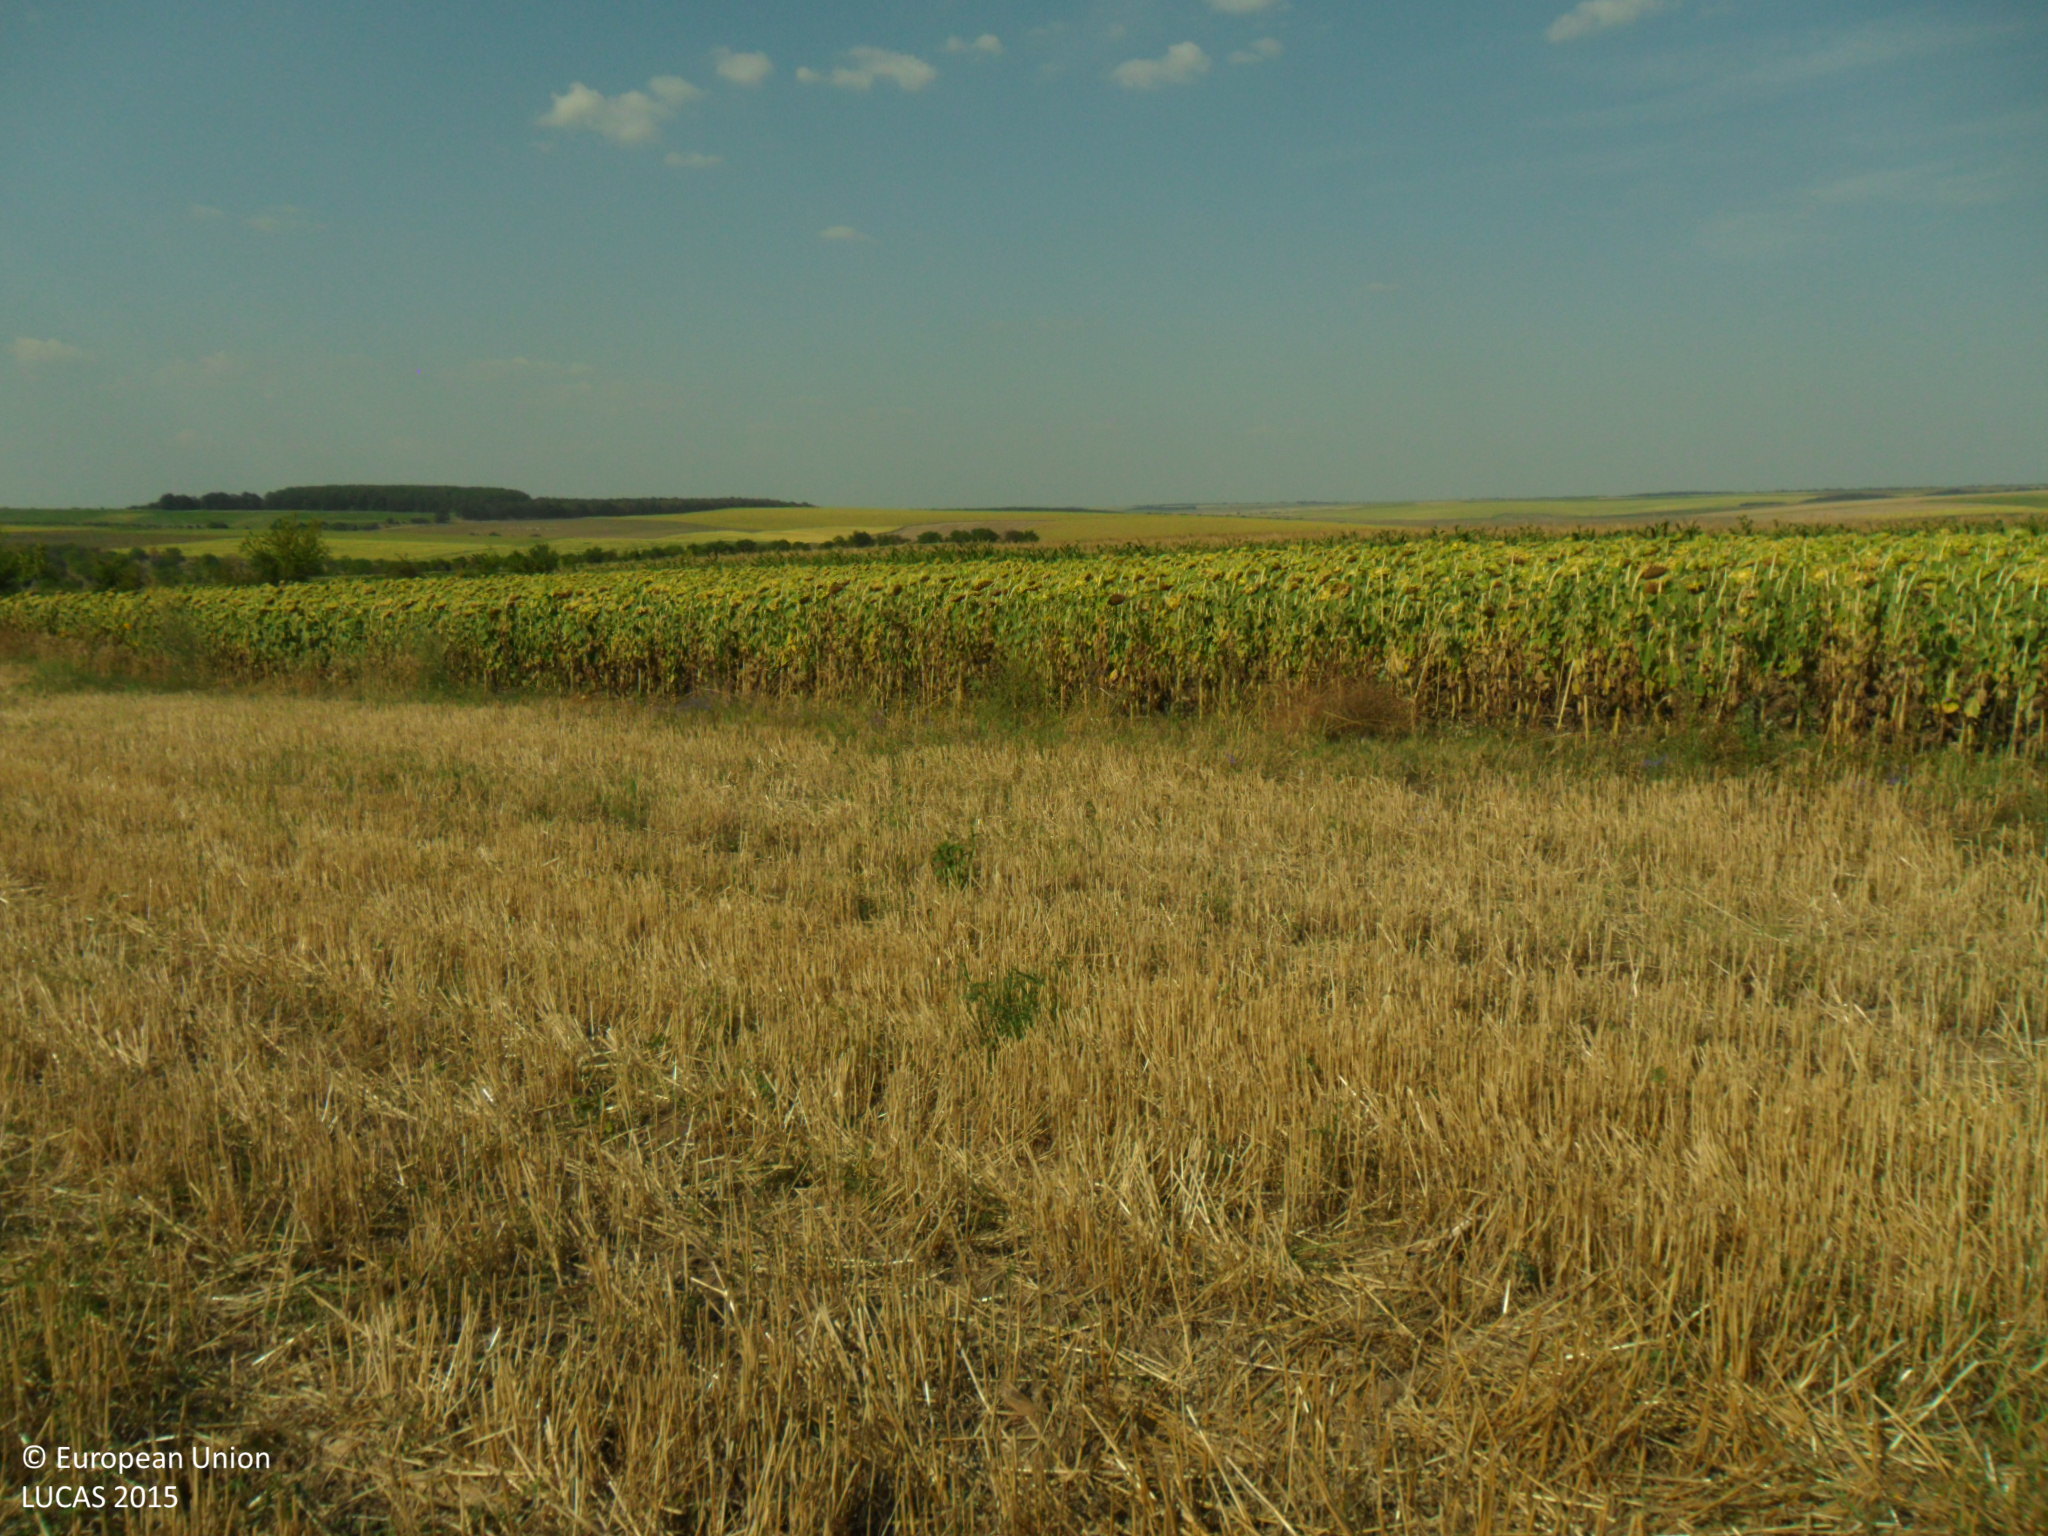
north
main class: Cropland
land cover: Common wheat
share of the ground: 25 - 50 %
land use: Agriculture (excluding fallow land and kitchen gardens)
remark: Harvested field
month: August
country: BG
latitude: 43.6428
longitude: 27.1692
